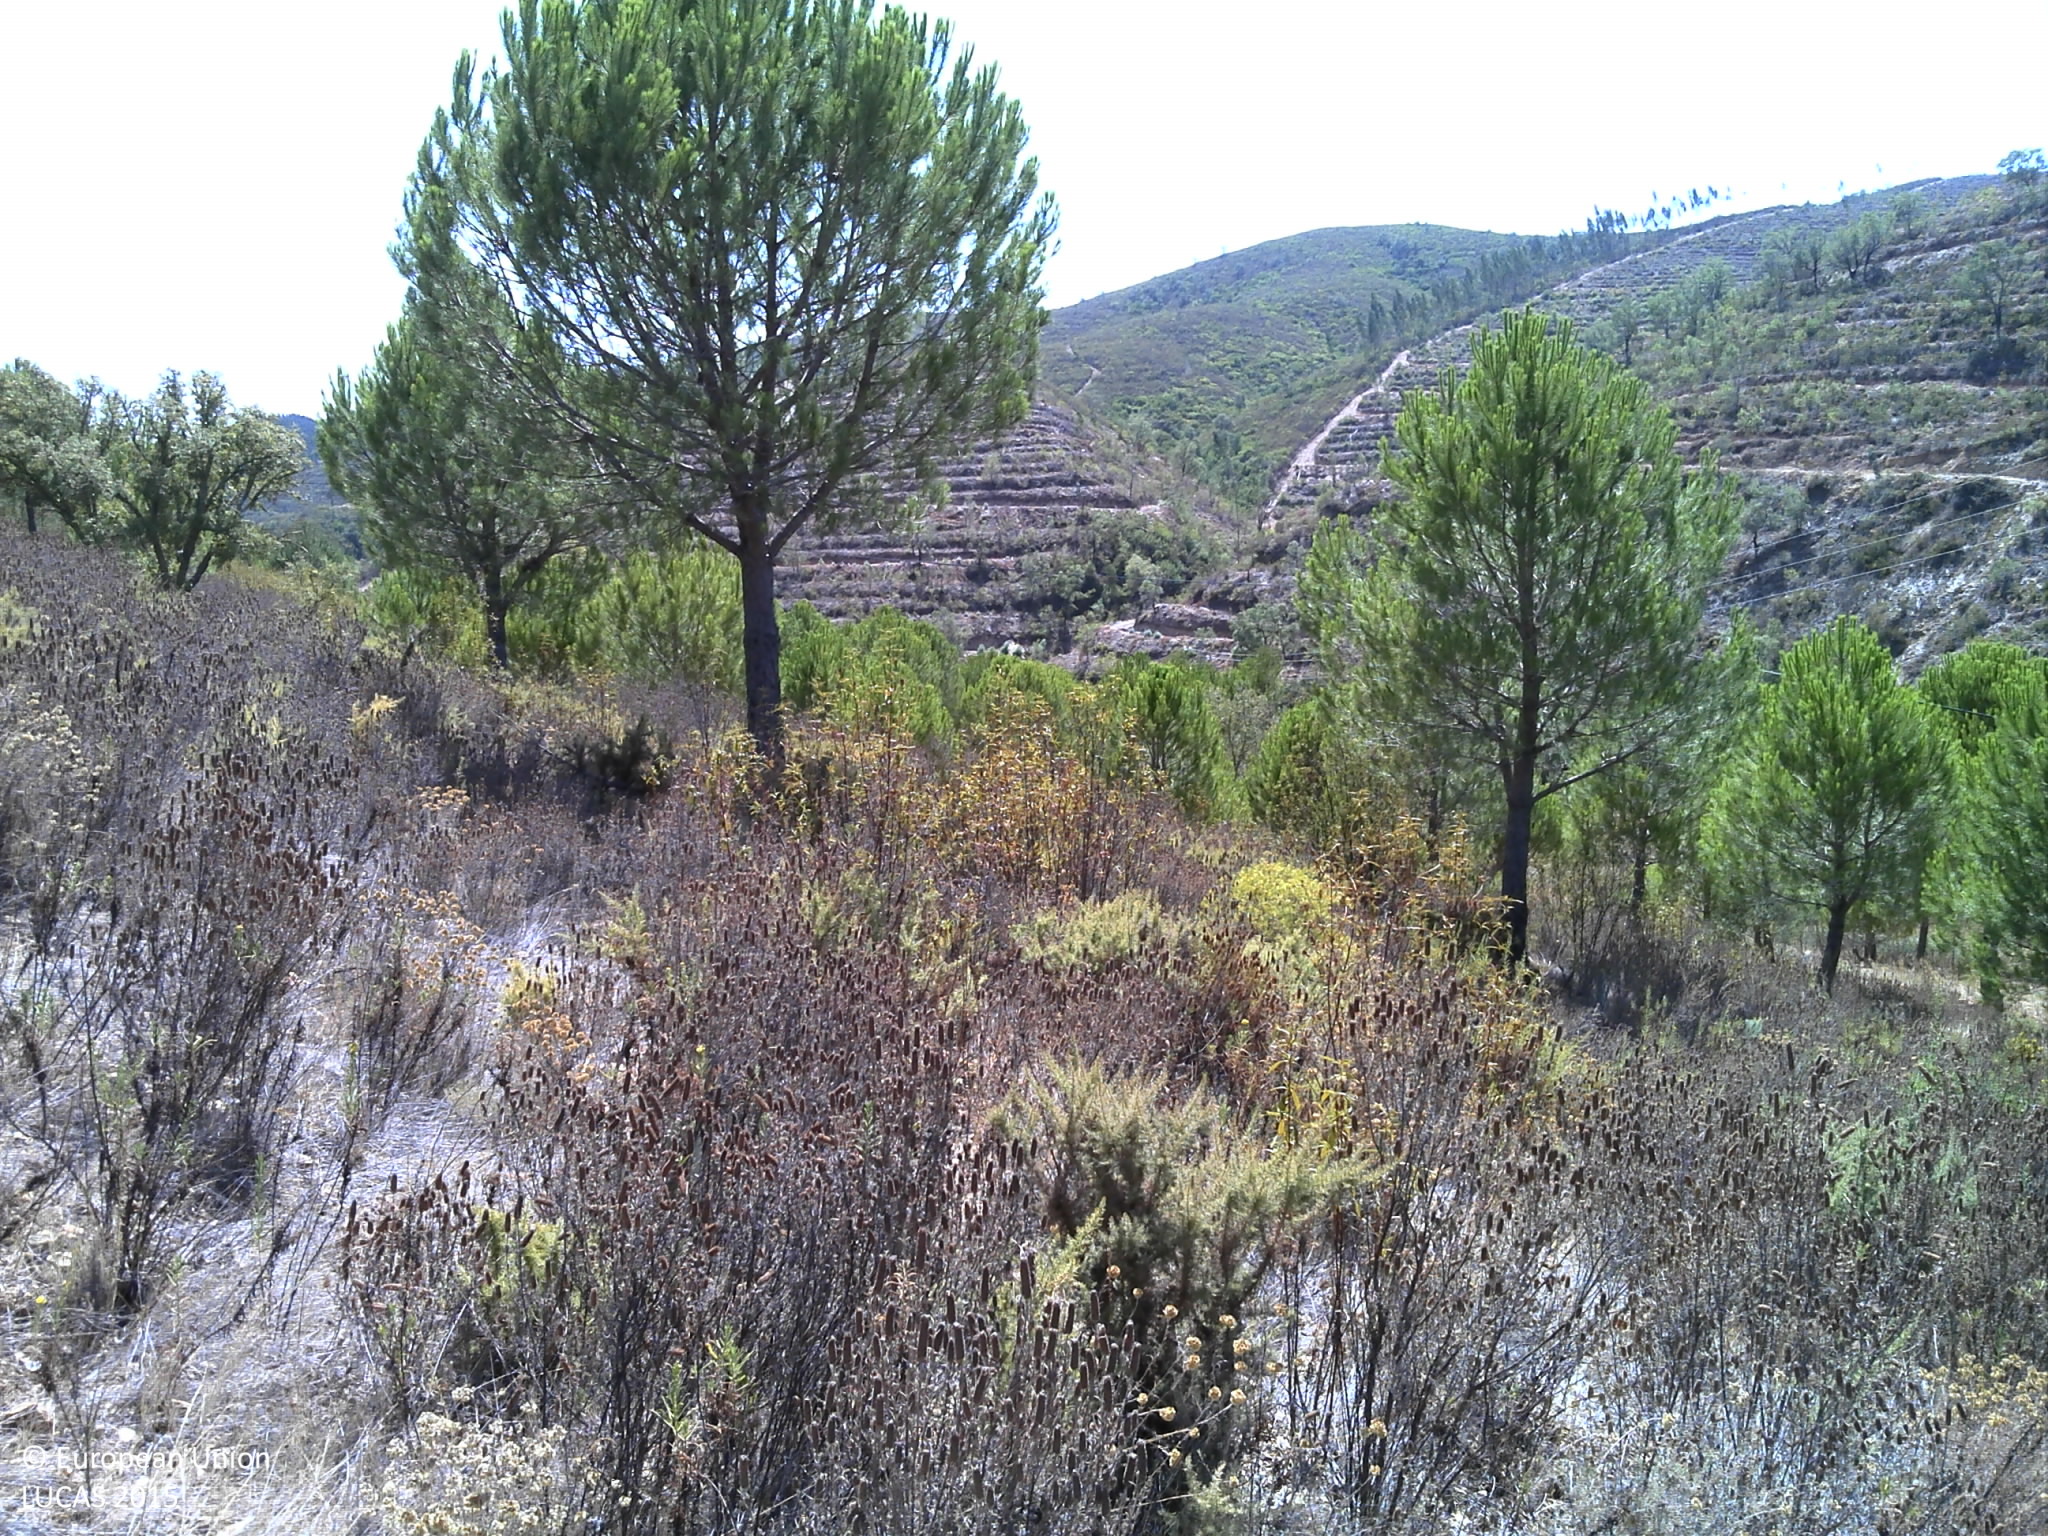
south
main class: Grassland
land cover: Grassland with sparse tree/shrub cover
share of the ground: 50 - 75 %
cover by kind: herbaceous plants 60 %, unconsolidated bare surface 35 %, broadleaved forest trees 5 %
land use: Forestry
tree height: < 5 m
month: September
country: PT
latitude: 37.3664
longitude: -8.1899
